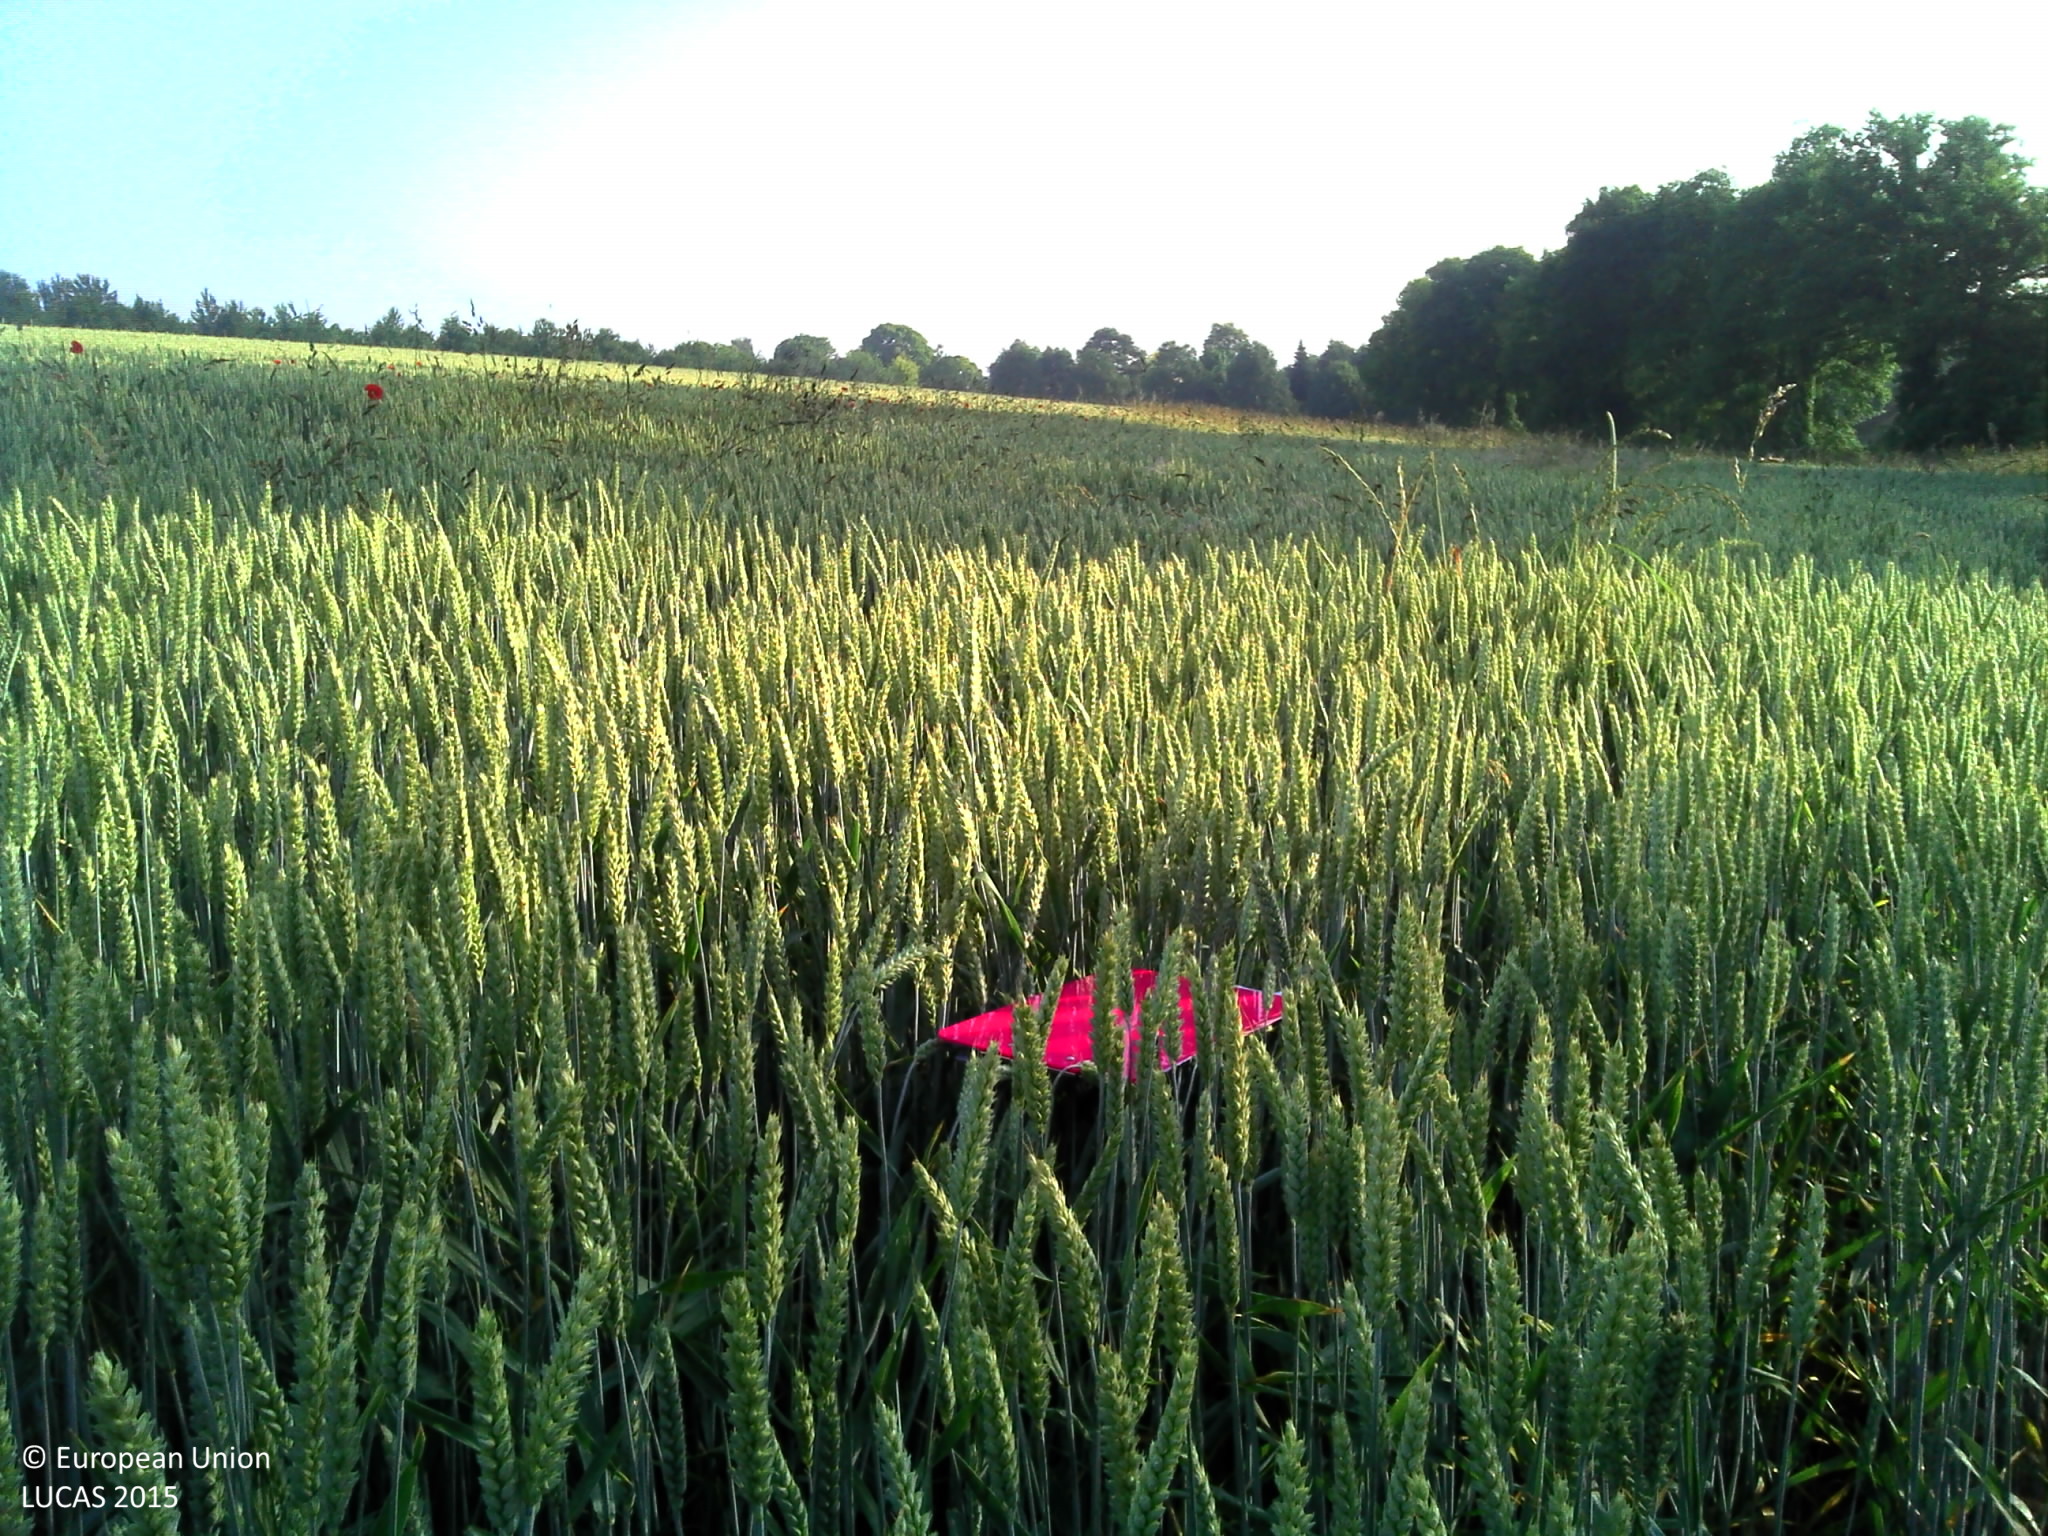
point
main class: Cropland
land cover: Common wheat
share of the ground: > 75 %
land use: Agriculture (excluding fallow land and kitchen gardens)
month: June
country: FR
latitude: 48.2441
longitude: -1.7789
